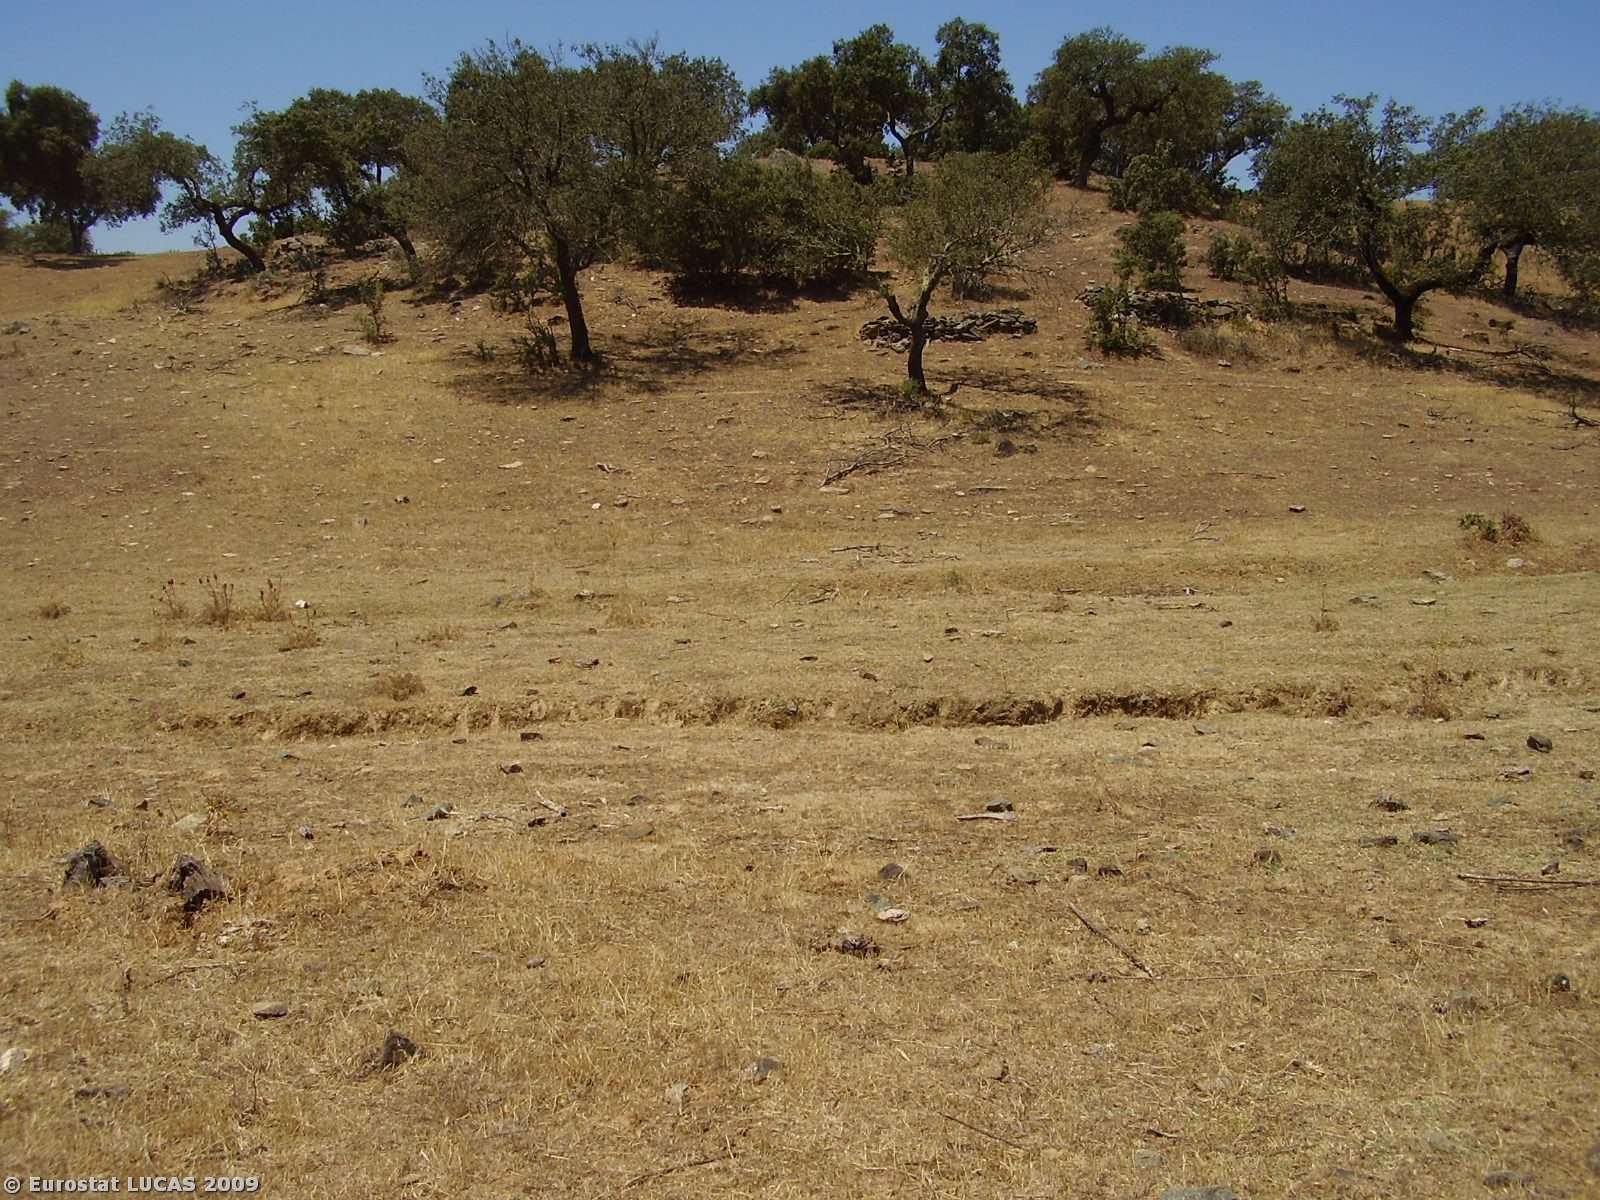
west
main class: Grassland
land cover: Grassland with sparse tree/shrub cover
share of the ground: > 75 %
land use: Fallow land
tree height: > 5 m
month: July
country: PT
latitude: 38.8285
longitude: -7.2969
